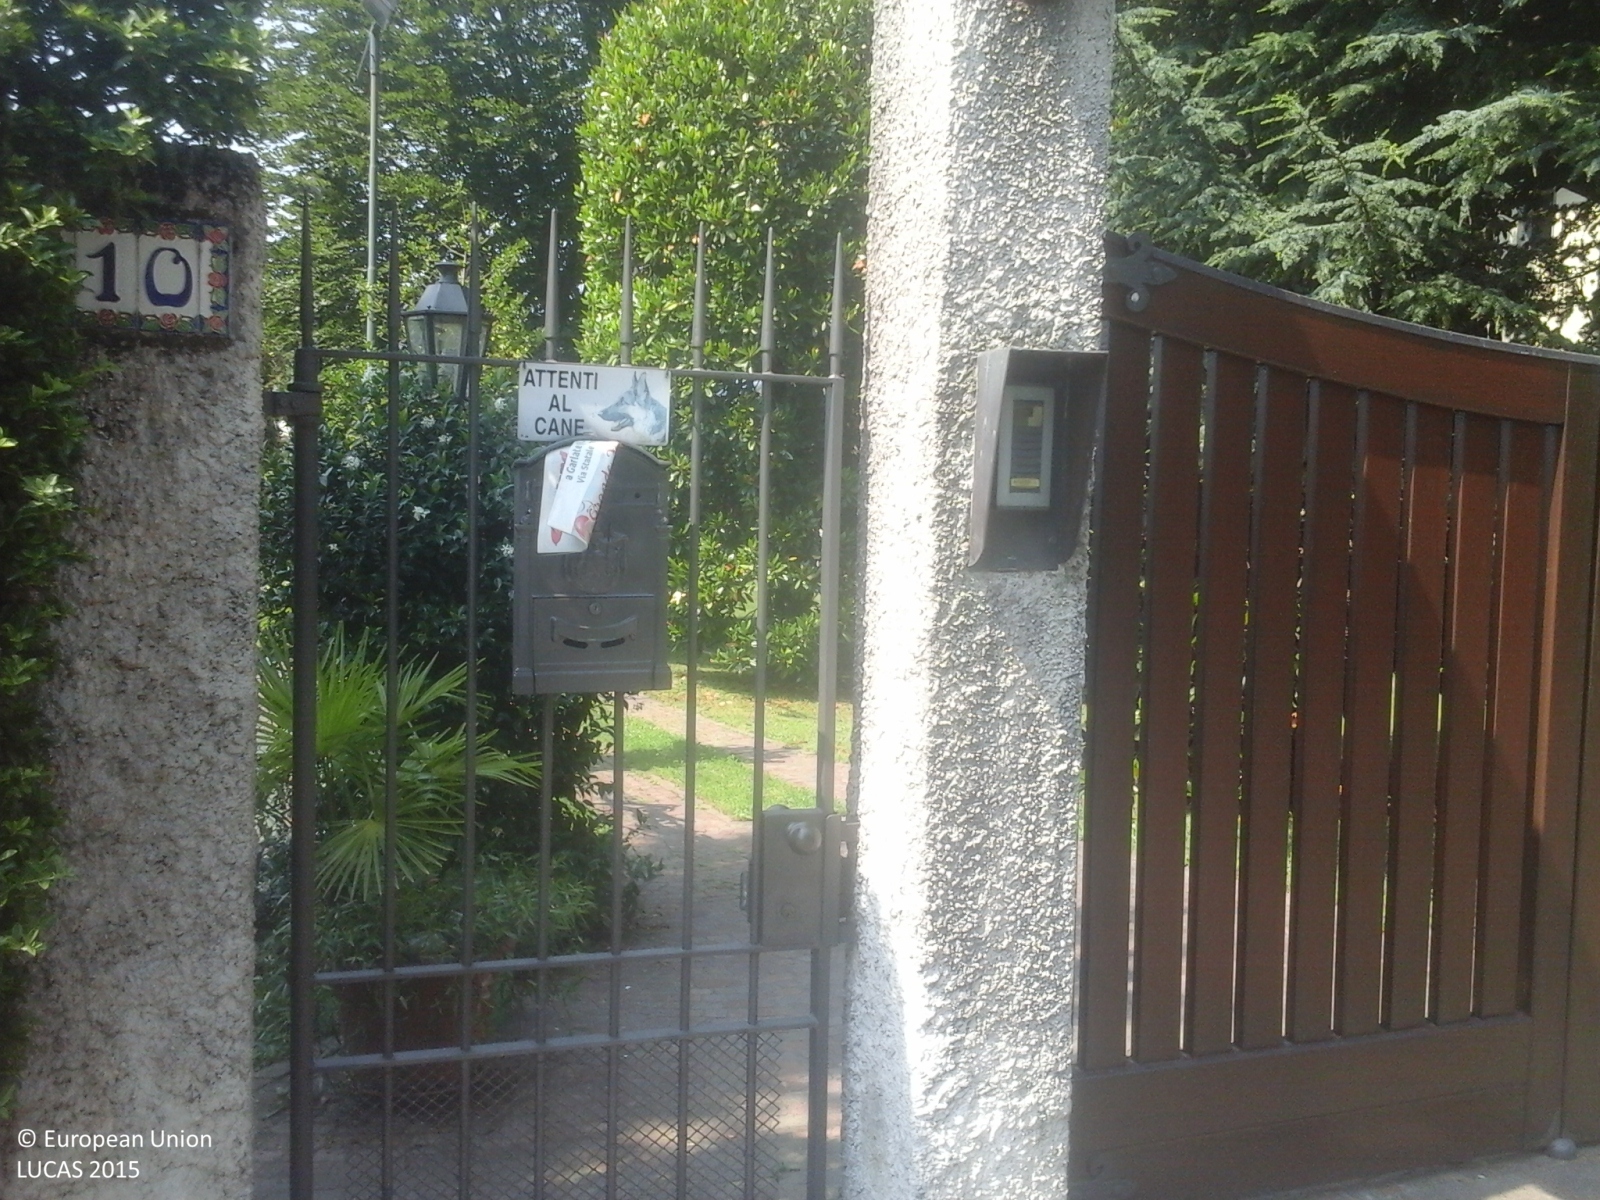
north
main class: Woodland
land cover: Broadleaved woodland
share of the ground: > 75 %
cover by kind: broadleaved forest trees 95 %, shrubs 5 %
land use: Residential
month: July
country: IT
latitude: 45.8092
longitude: 9.4218
